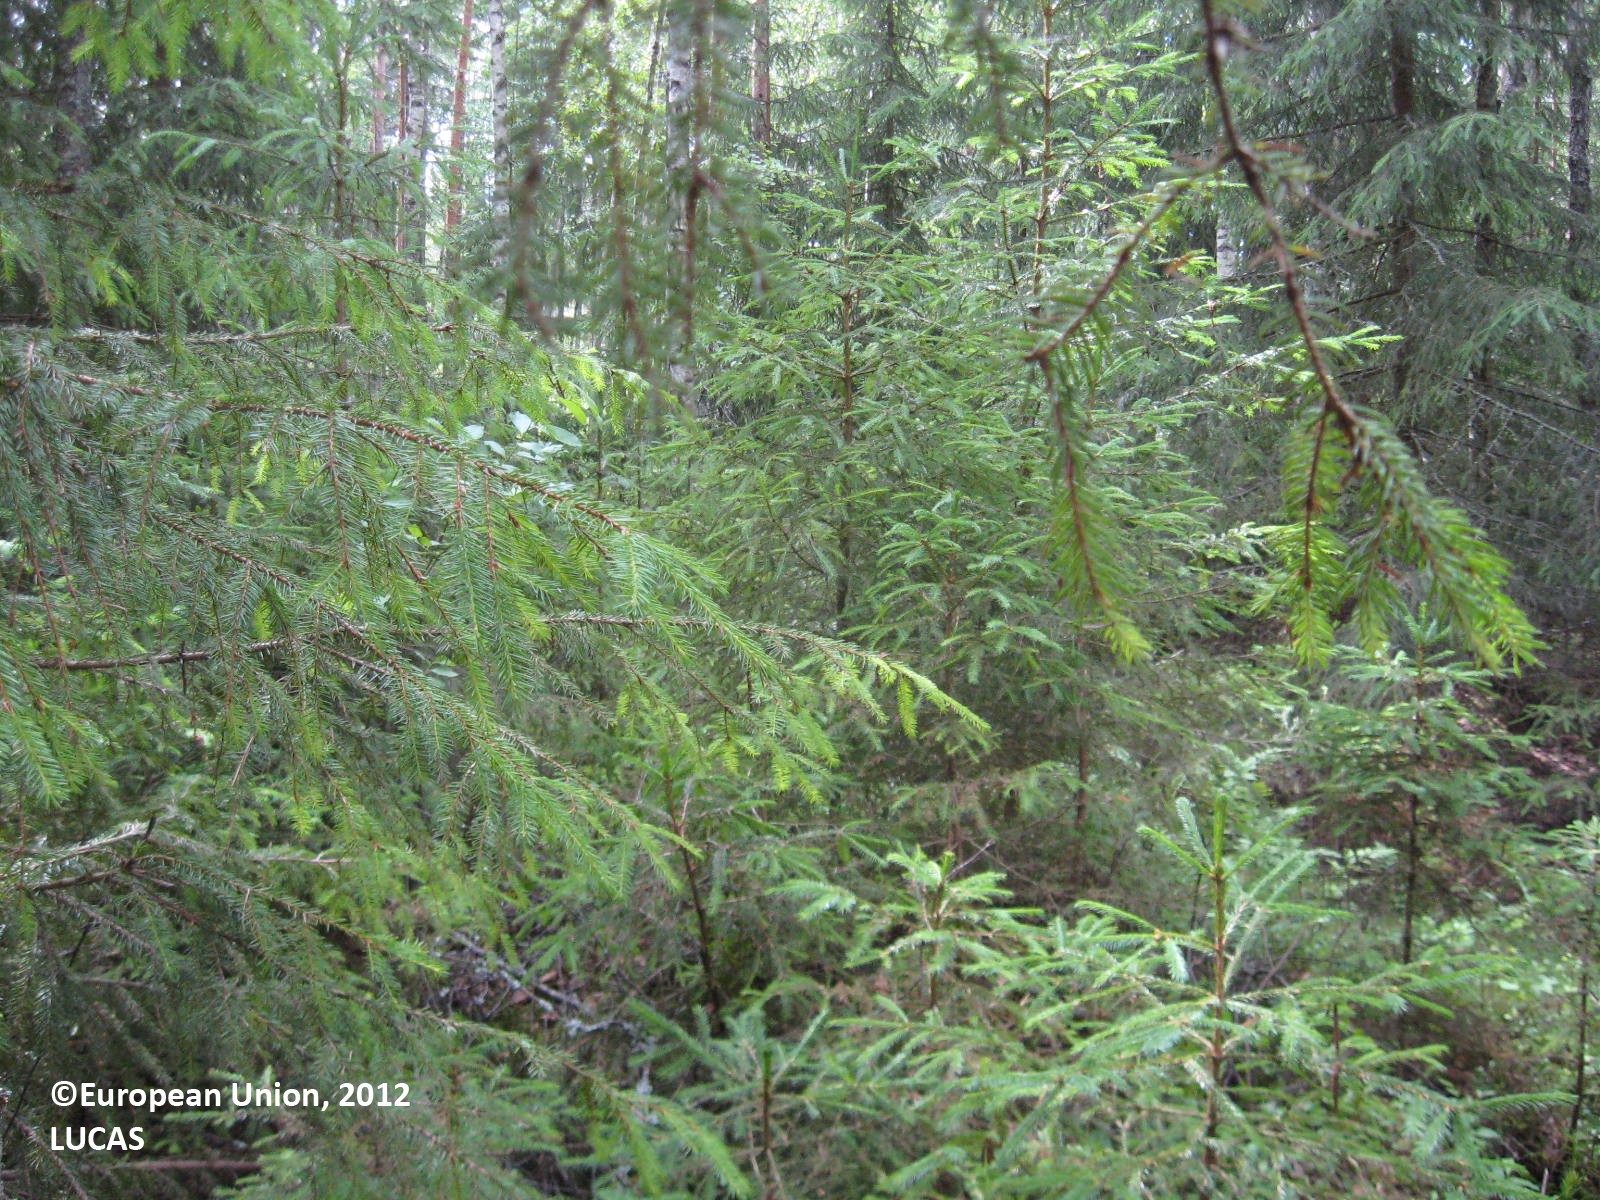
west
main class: Woodland
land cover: Other coniferous woodland
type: boreal forest
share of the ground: > 75 %
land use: Forestry
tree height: > 5 m
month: July
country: FI
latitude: 62.6656
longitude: 22.6078
